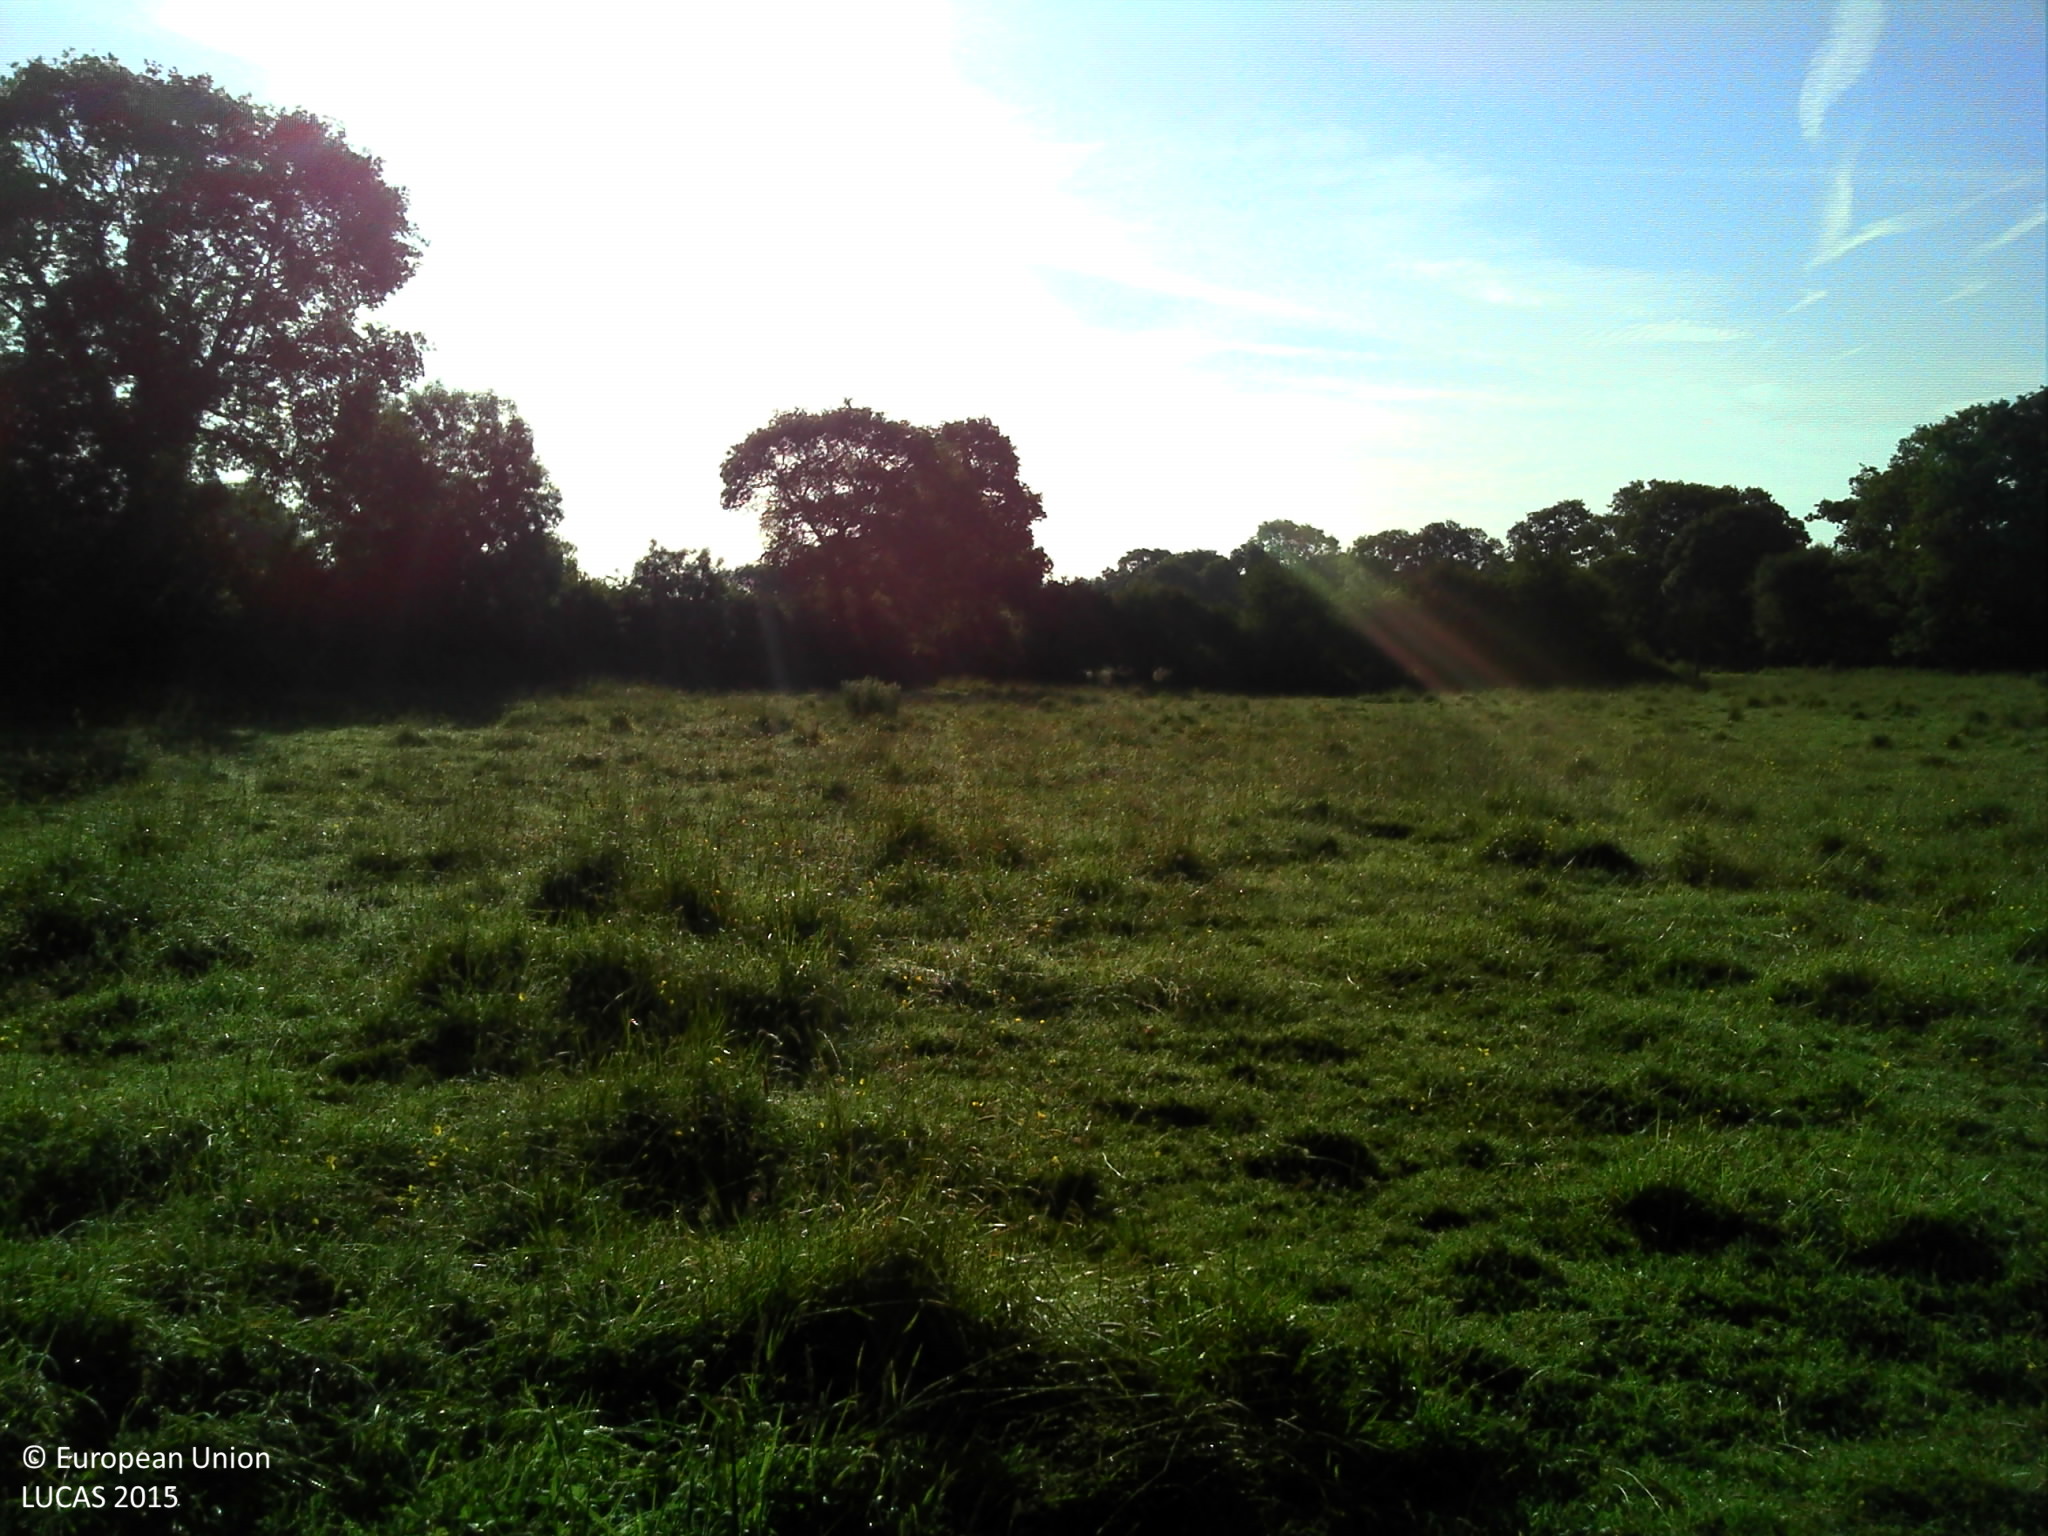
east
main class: Grassland
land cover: Grassland without tree/shrub cover
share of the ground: > 75 %
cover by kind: herbaceous plants 100 %
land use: Agriculture (excluding fallow land and kitchen gardens)
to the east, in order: Grassland without tree/shrub cover; Abandoned hedges; Grassland with sparse tree/shrub cover
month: June
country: FR
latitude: 49.3349
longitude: -1.4290
